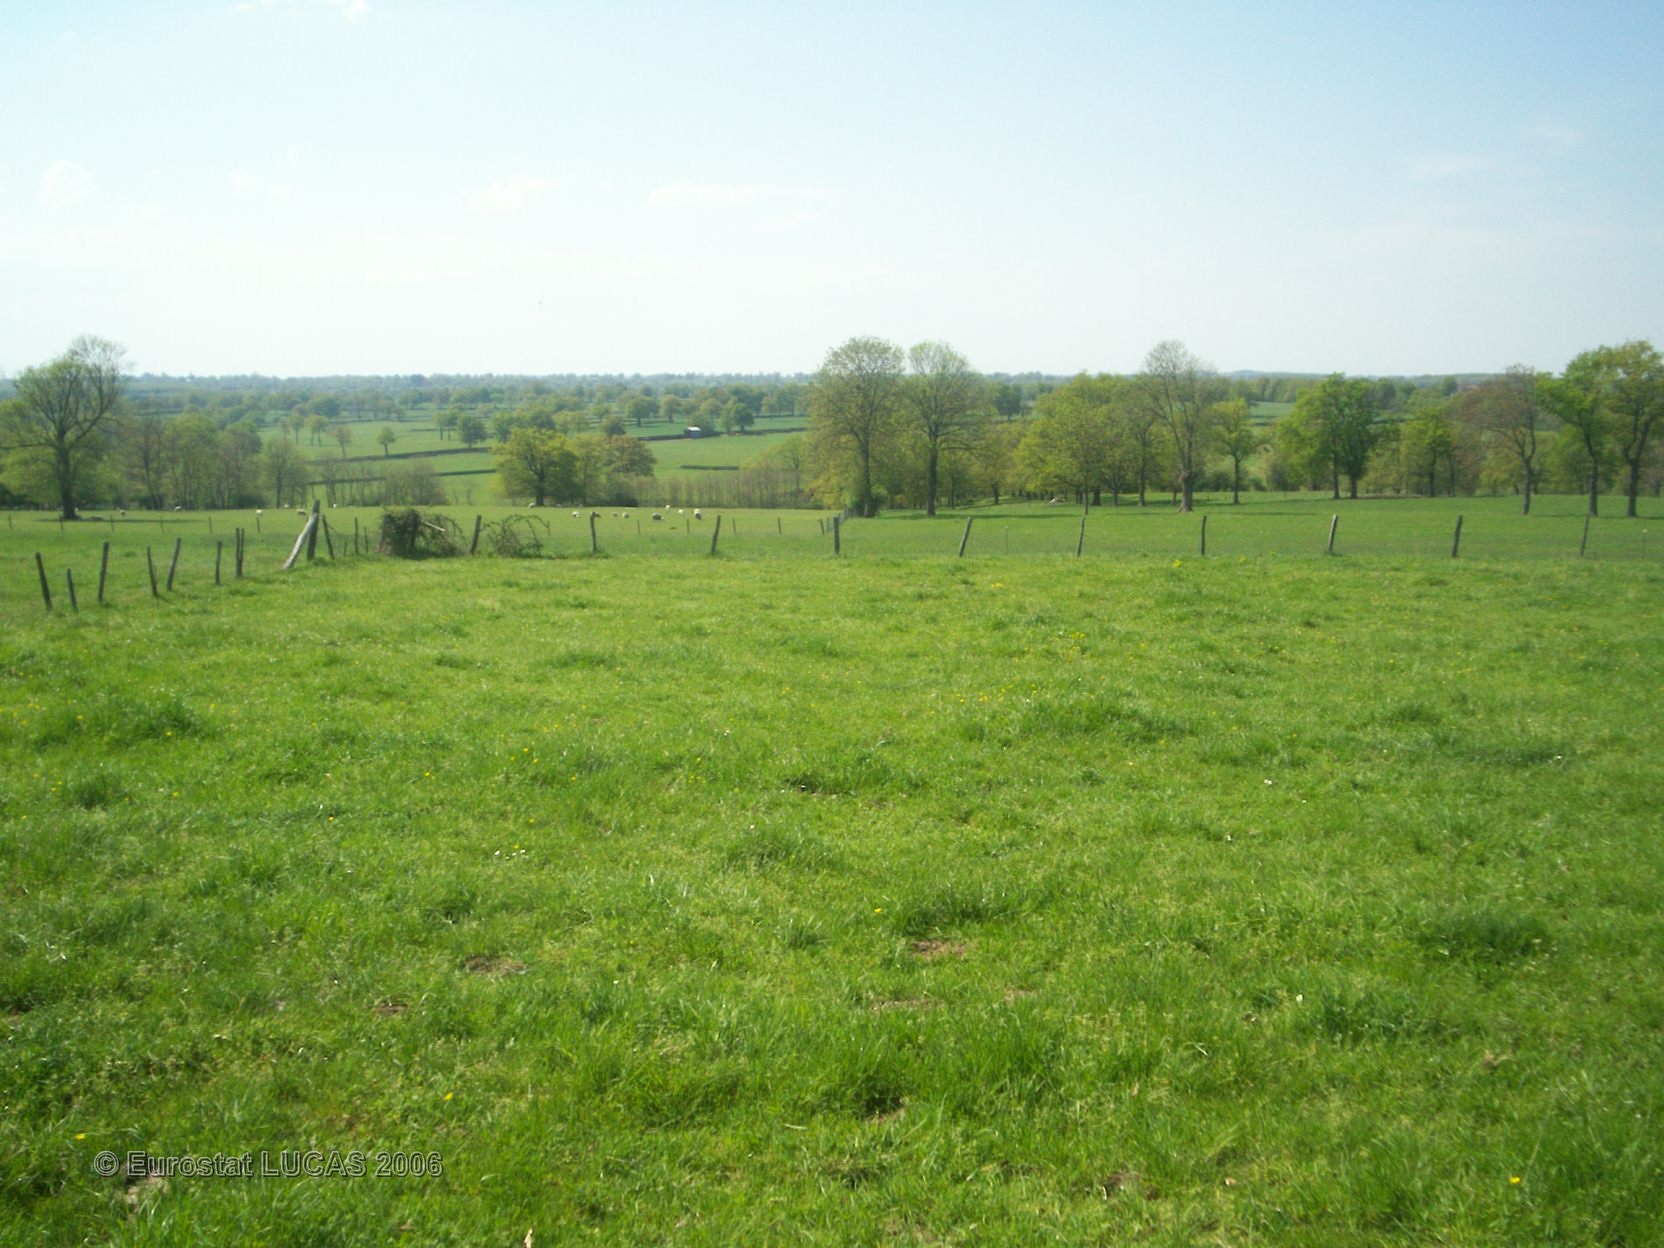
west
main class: Grassland
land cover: Grassland without tree/shrub cover
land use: Agriculture (excluding fallow land and kitchen gardens)
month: May
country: FR
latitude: 46.3288
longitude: 3.1266
